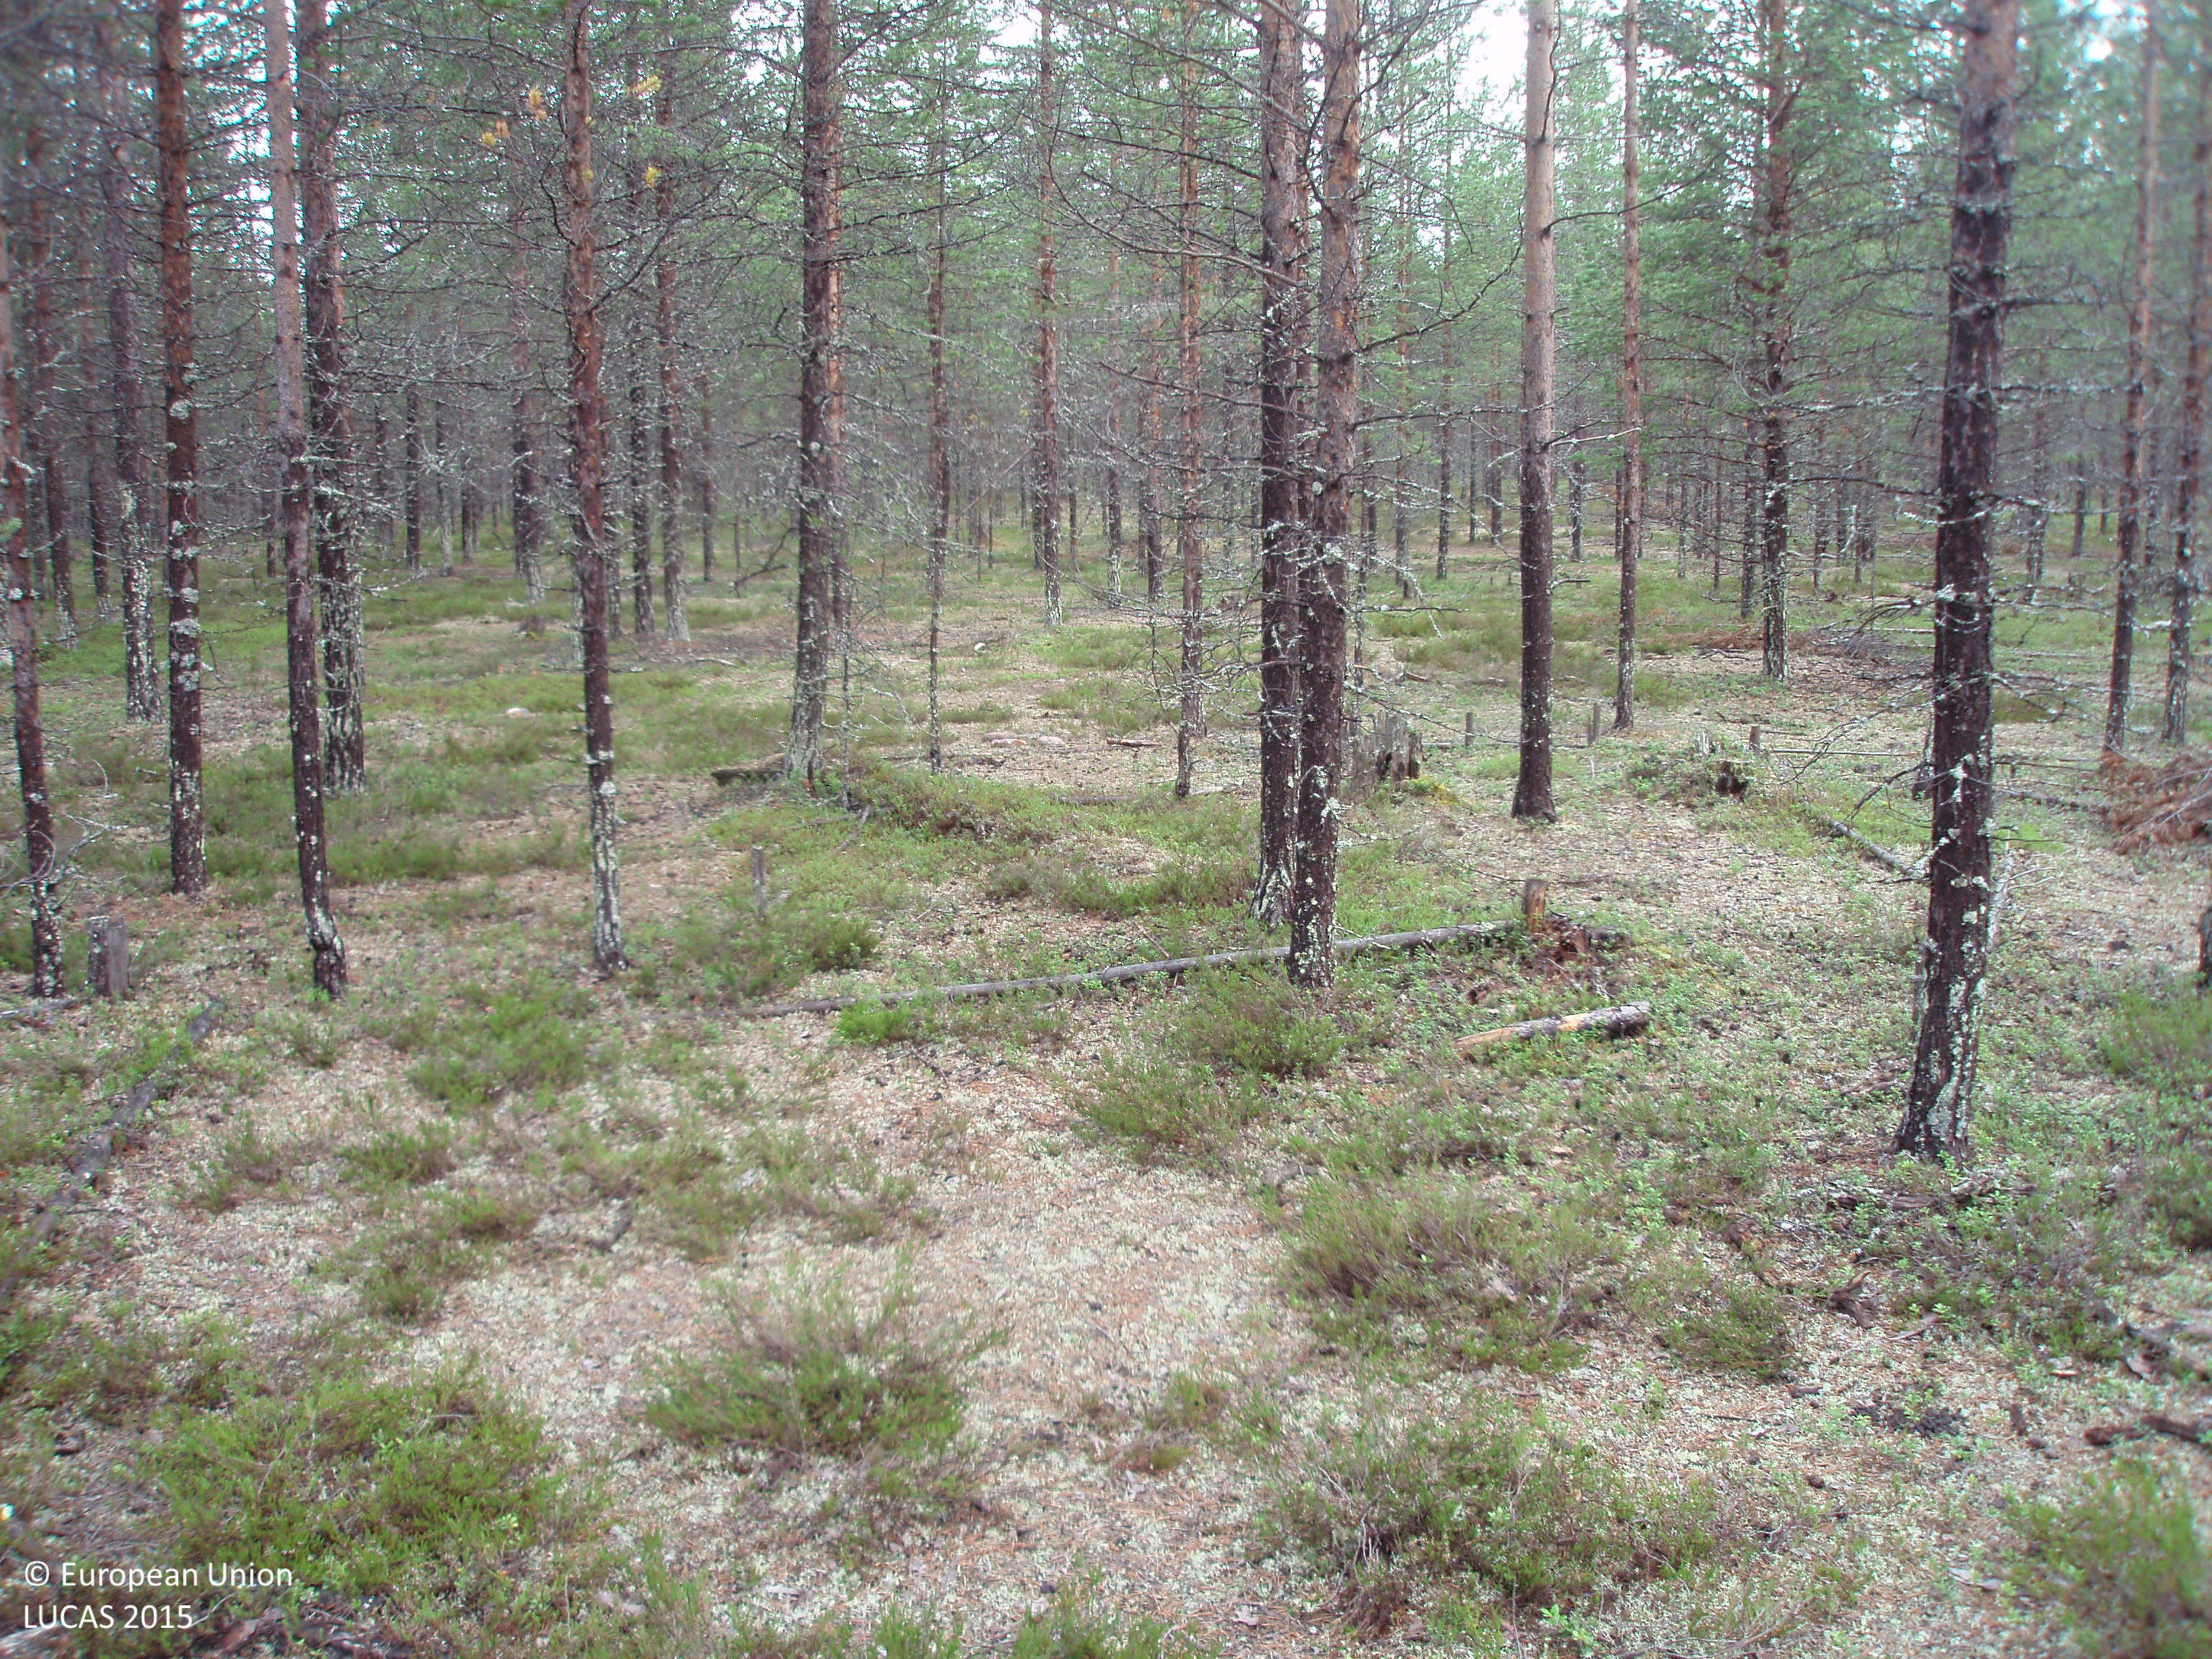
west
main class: Woodland
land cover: Pine dominated coniferous woodland
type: boreal forest
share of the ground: > 75 %
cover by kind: coniferous forest trees 75 %, shrubs 20 %, lichens and mosses 5 %
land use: Forestry
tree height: > 5 m
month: July
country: FI
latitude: 65.9992
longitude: 28.0515
